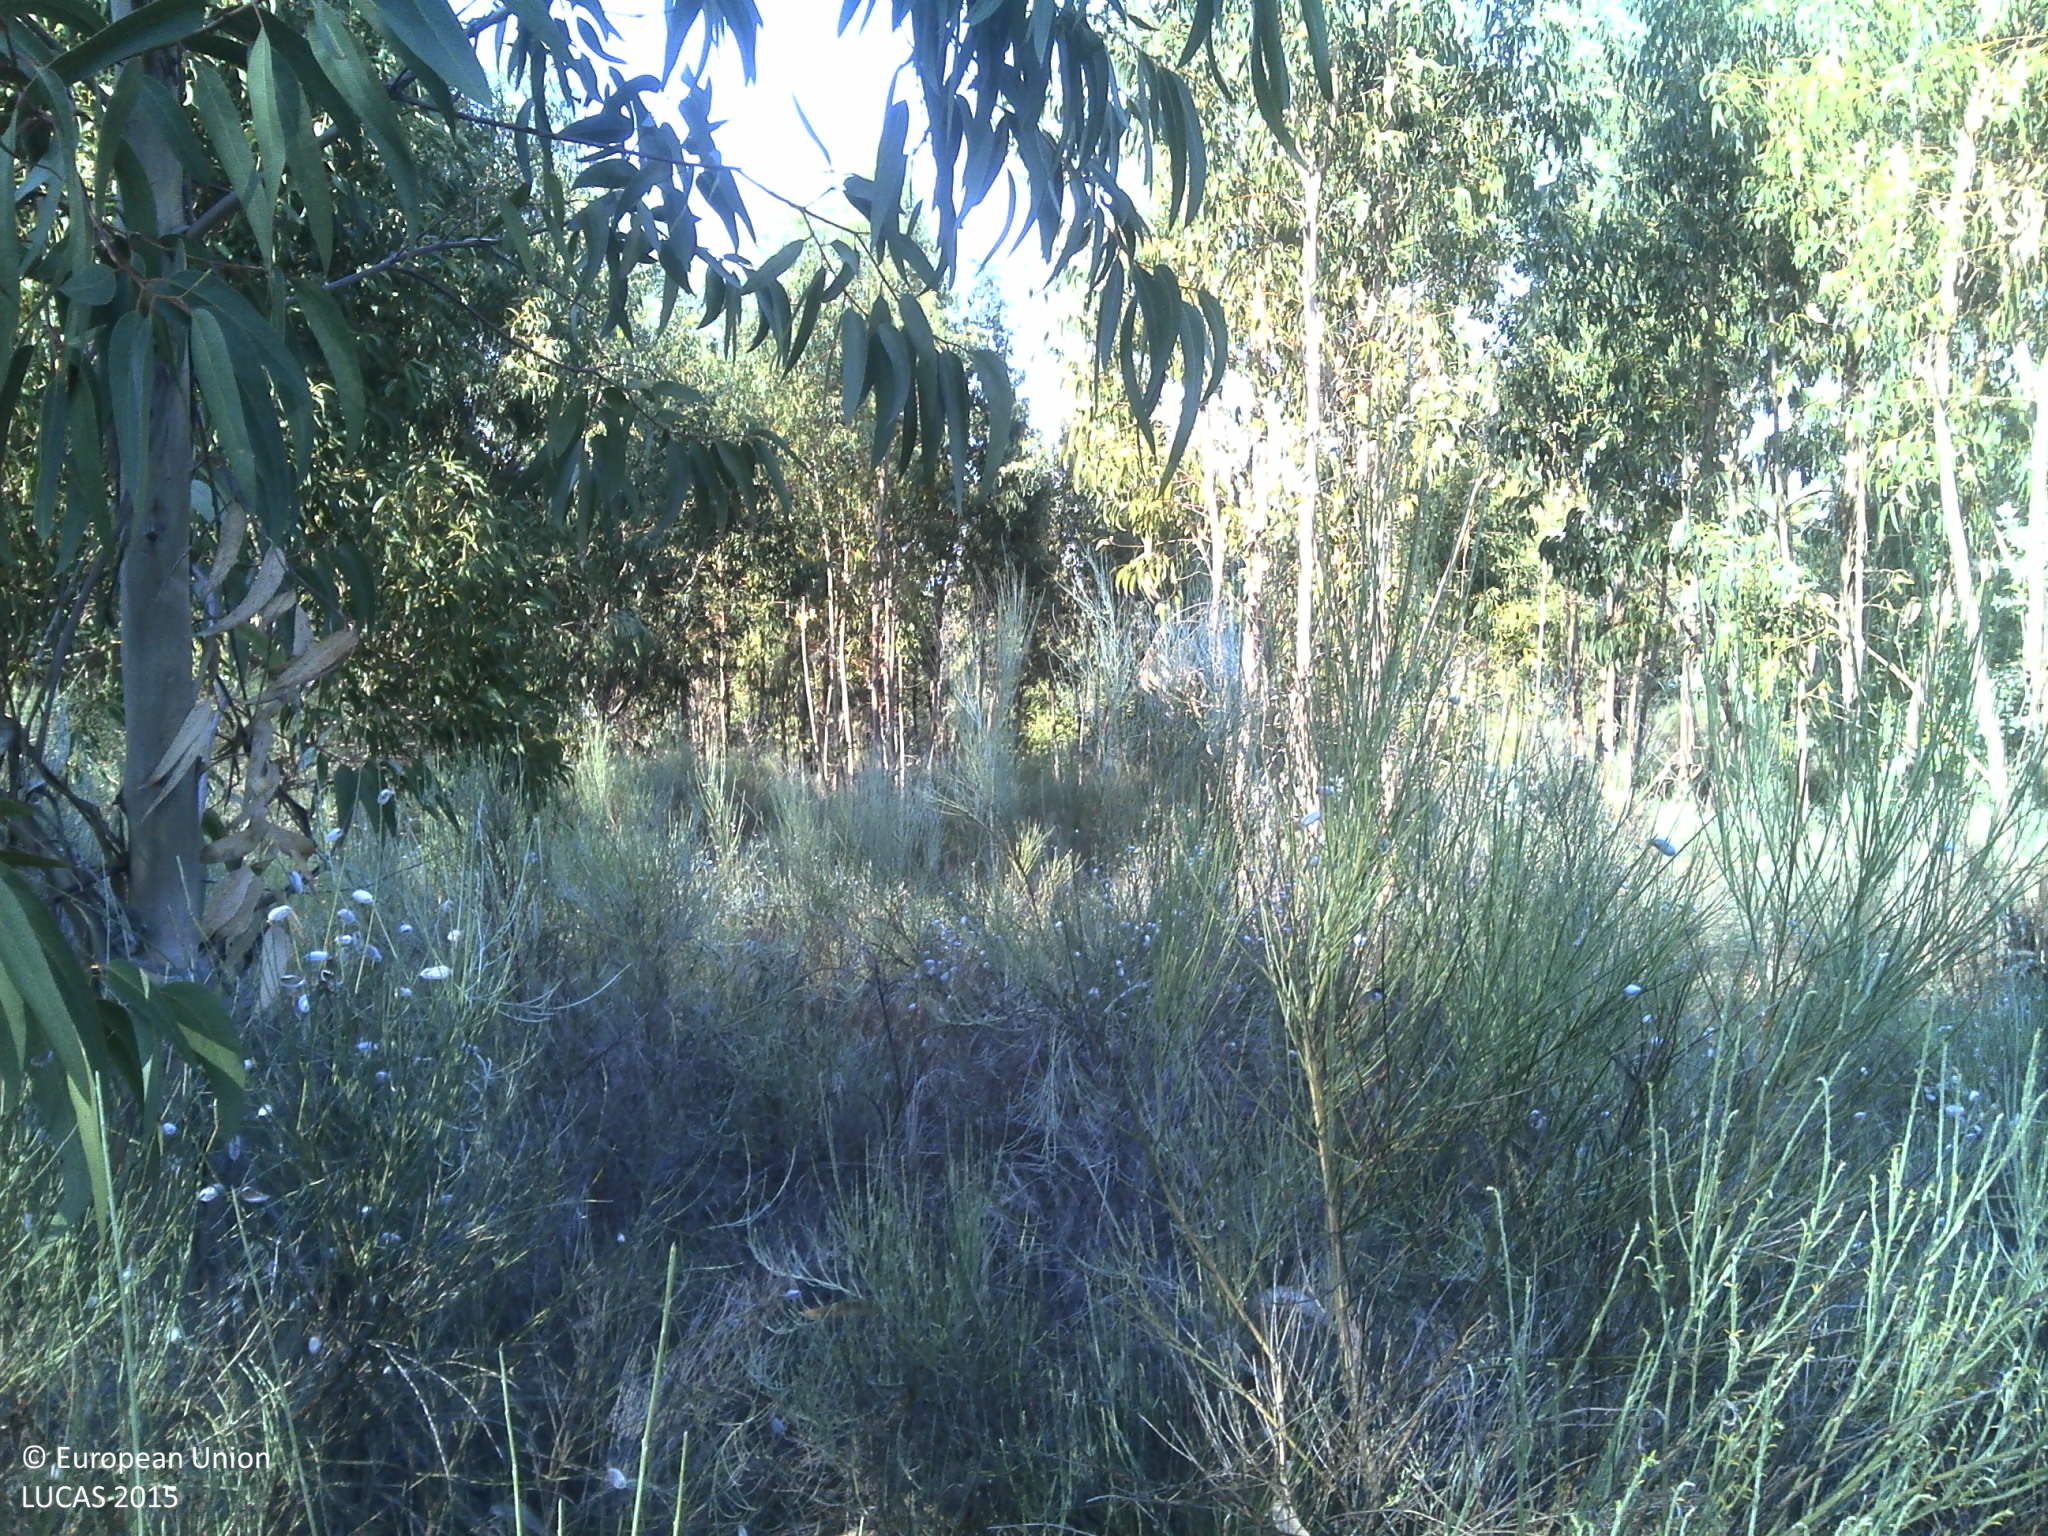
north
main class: Woodland
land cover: Broadleaved woodland
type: exotic forest
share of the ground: 25 - 50 %
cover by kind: broadleaved forest trees 50 %, shrubs 35 %, unconsolidated bare surface 10 %
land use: Forestry
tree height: > 5 m
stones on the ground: 10 - 25 %
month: June
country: PT
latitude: 39.9074
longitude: -7.3509
